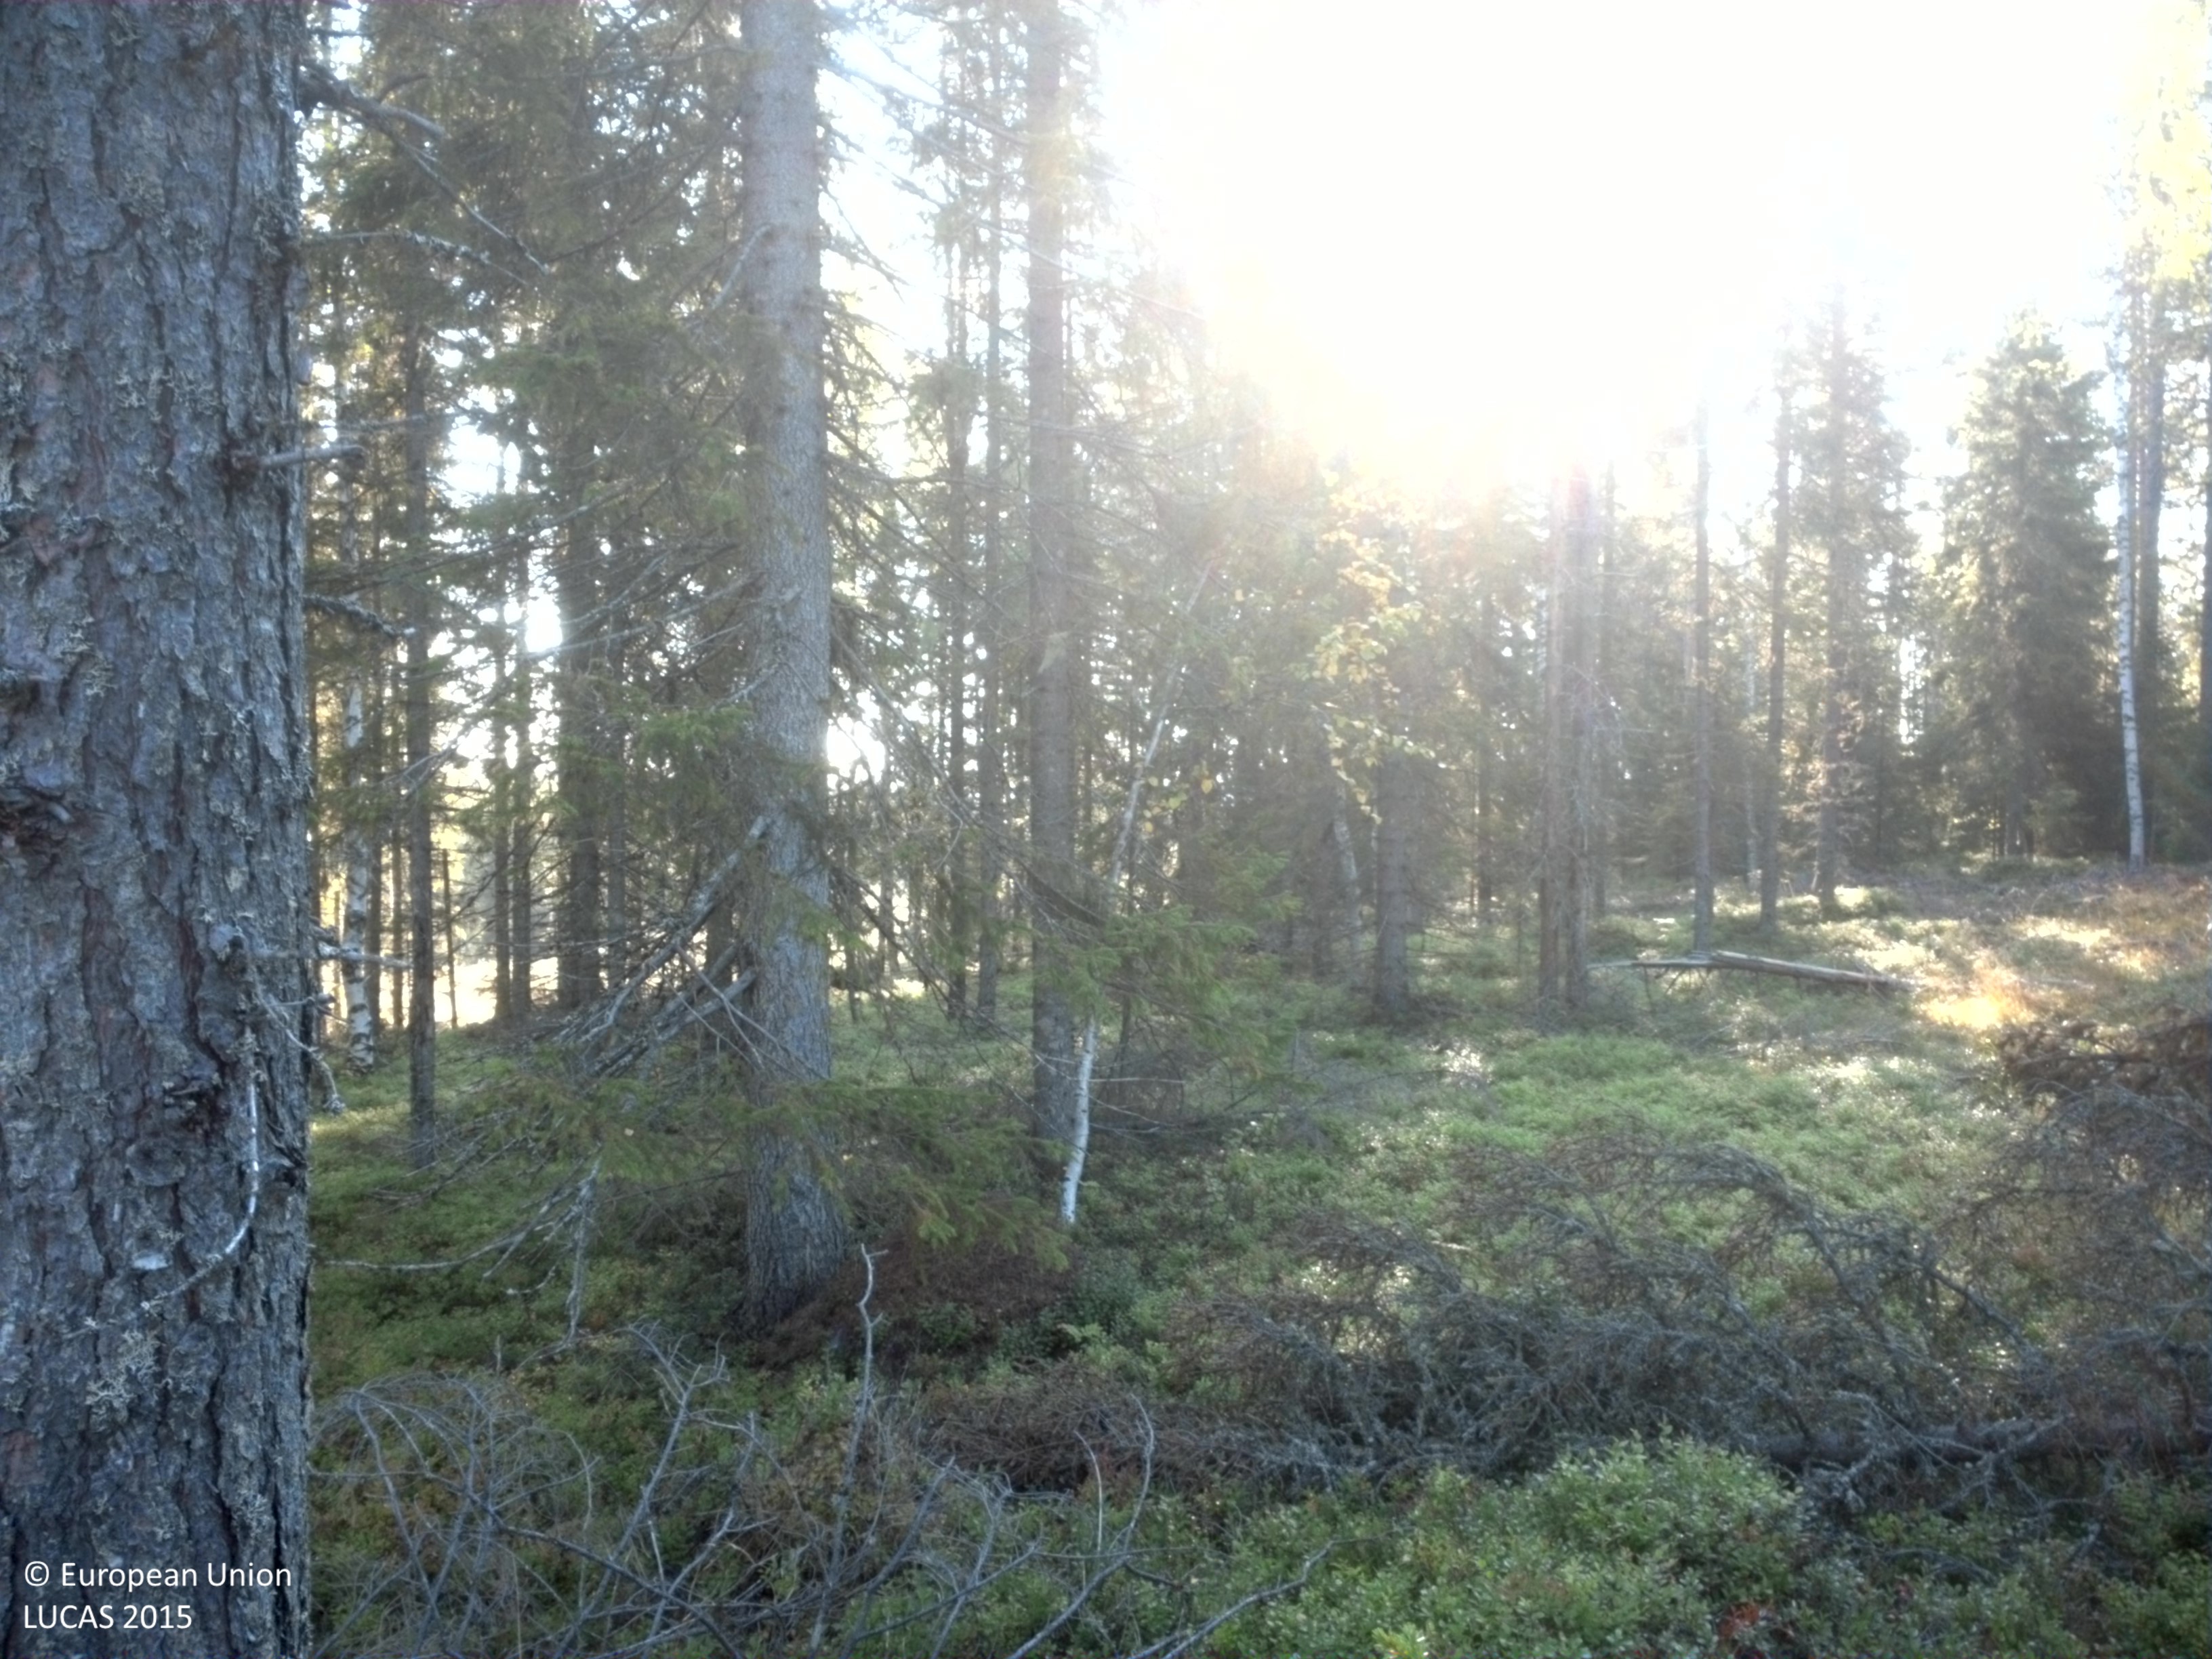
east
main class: Woodland
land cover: Spruce dominated coniferous woodland
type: boreal forest
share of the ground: 50 - 75 %
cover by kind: coniferous forest trees 50 %, shrubs 45 %, broadleaved forest trees 5 %
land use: Forestry
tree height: > 5 m
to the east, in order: Spruce dominated coniferous woodland; Spruce dominated mixed woodland; Shrubland with sparse tree cover; Broadleaved woodland; Spruce dominated mixed woodland; Spruce dominated coniferous woodland; Spruce dominated mixed woodland
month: September
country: SE
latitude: 64.3745
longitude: 19.9846
